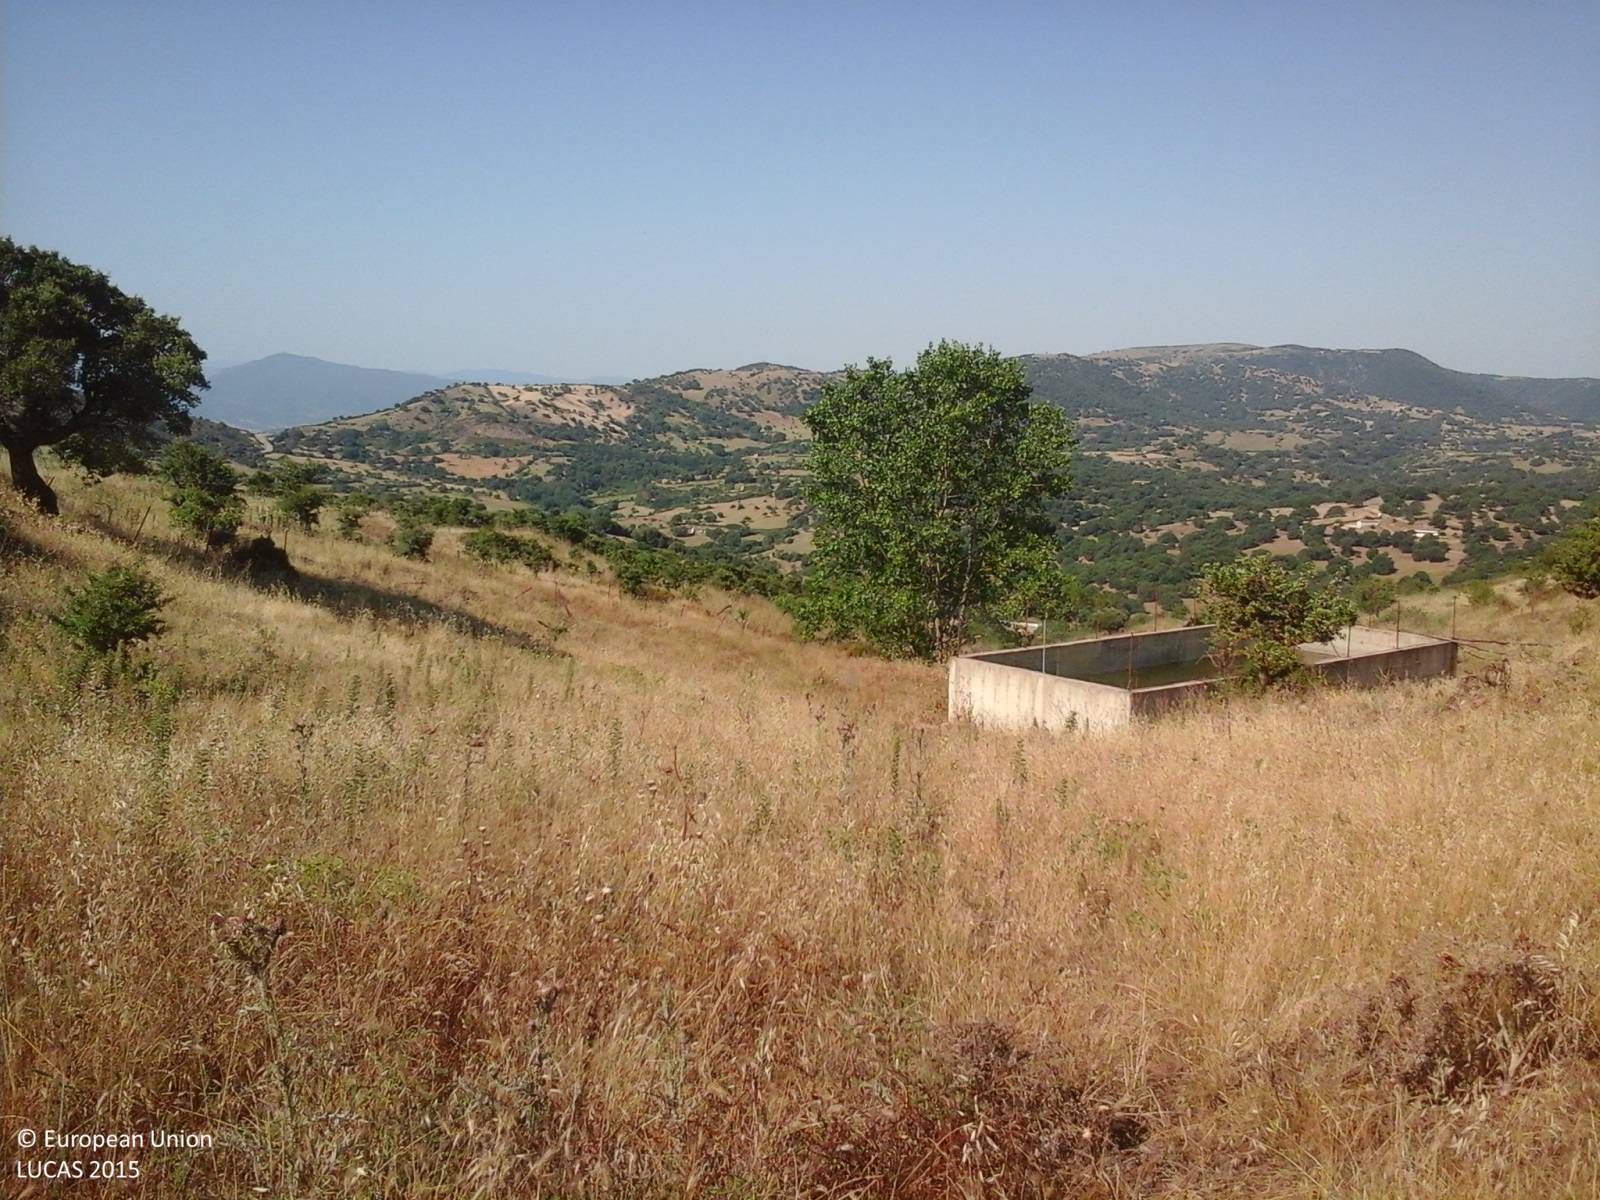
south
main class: Grassland
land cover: Grassland without tree/shrub cover
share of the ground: > 75 %
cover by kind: herbaceous plants 95 %, shrubs 5 %
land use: Agriculture (excluding fallow land and kitchen gardens)
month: July
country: IT
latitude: 40.4831
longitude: 9.4718
